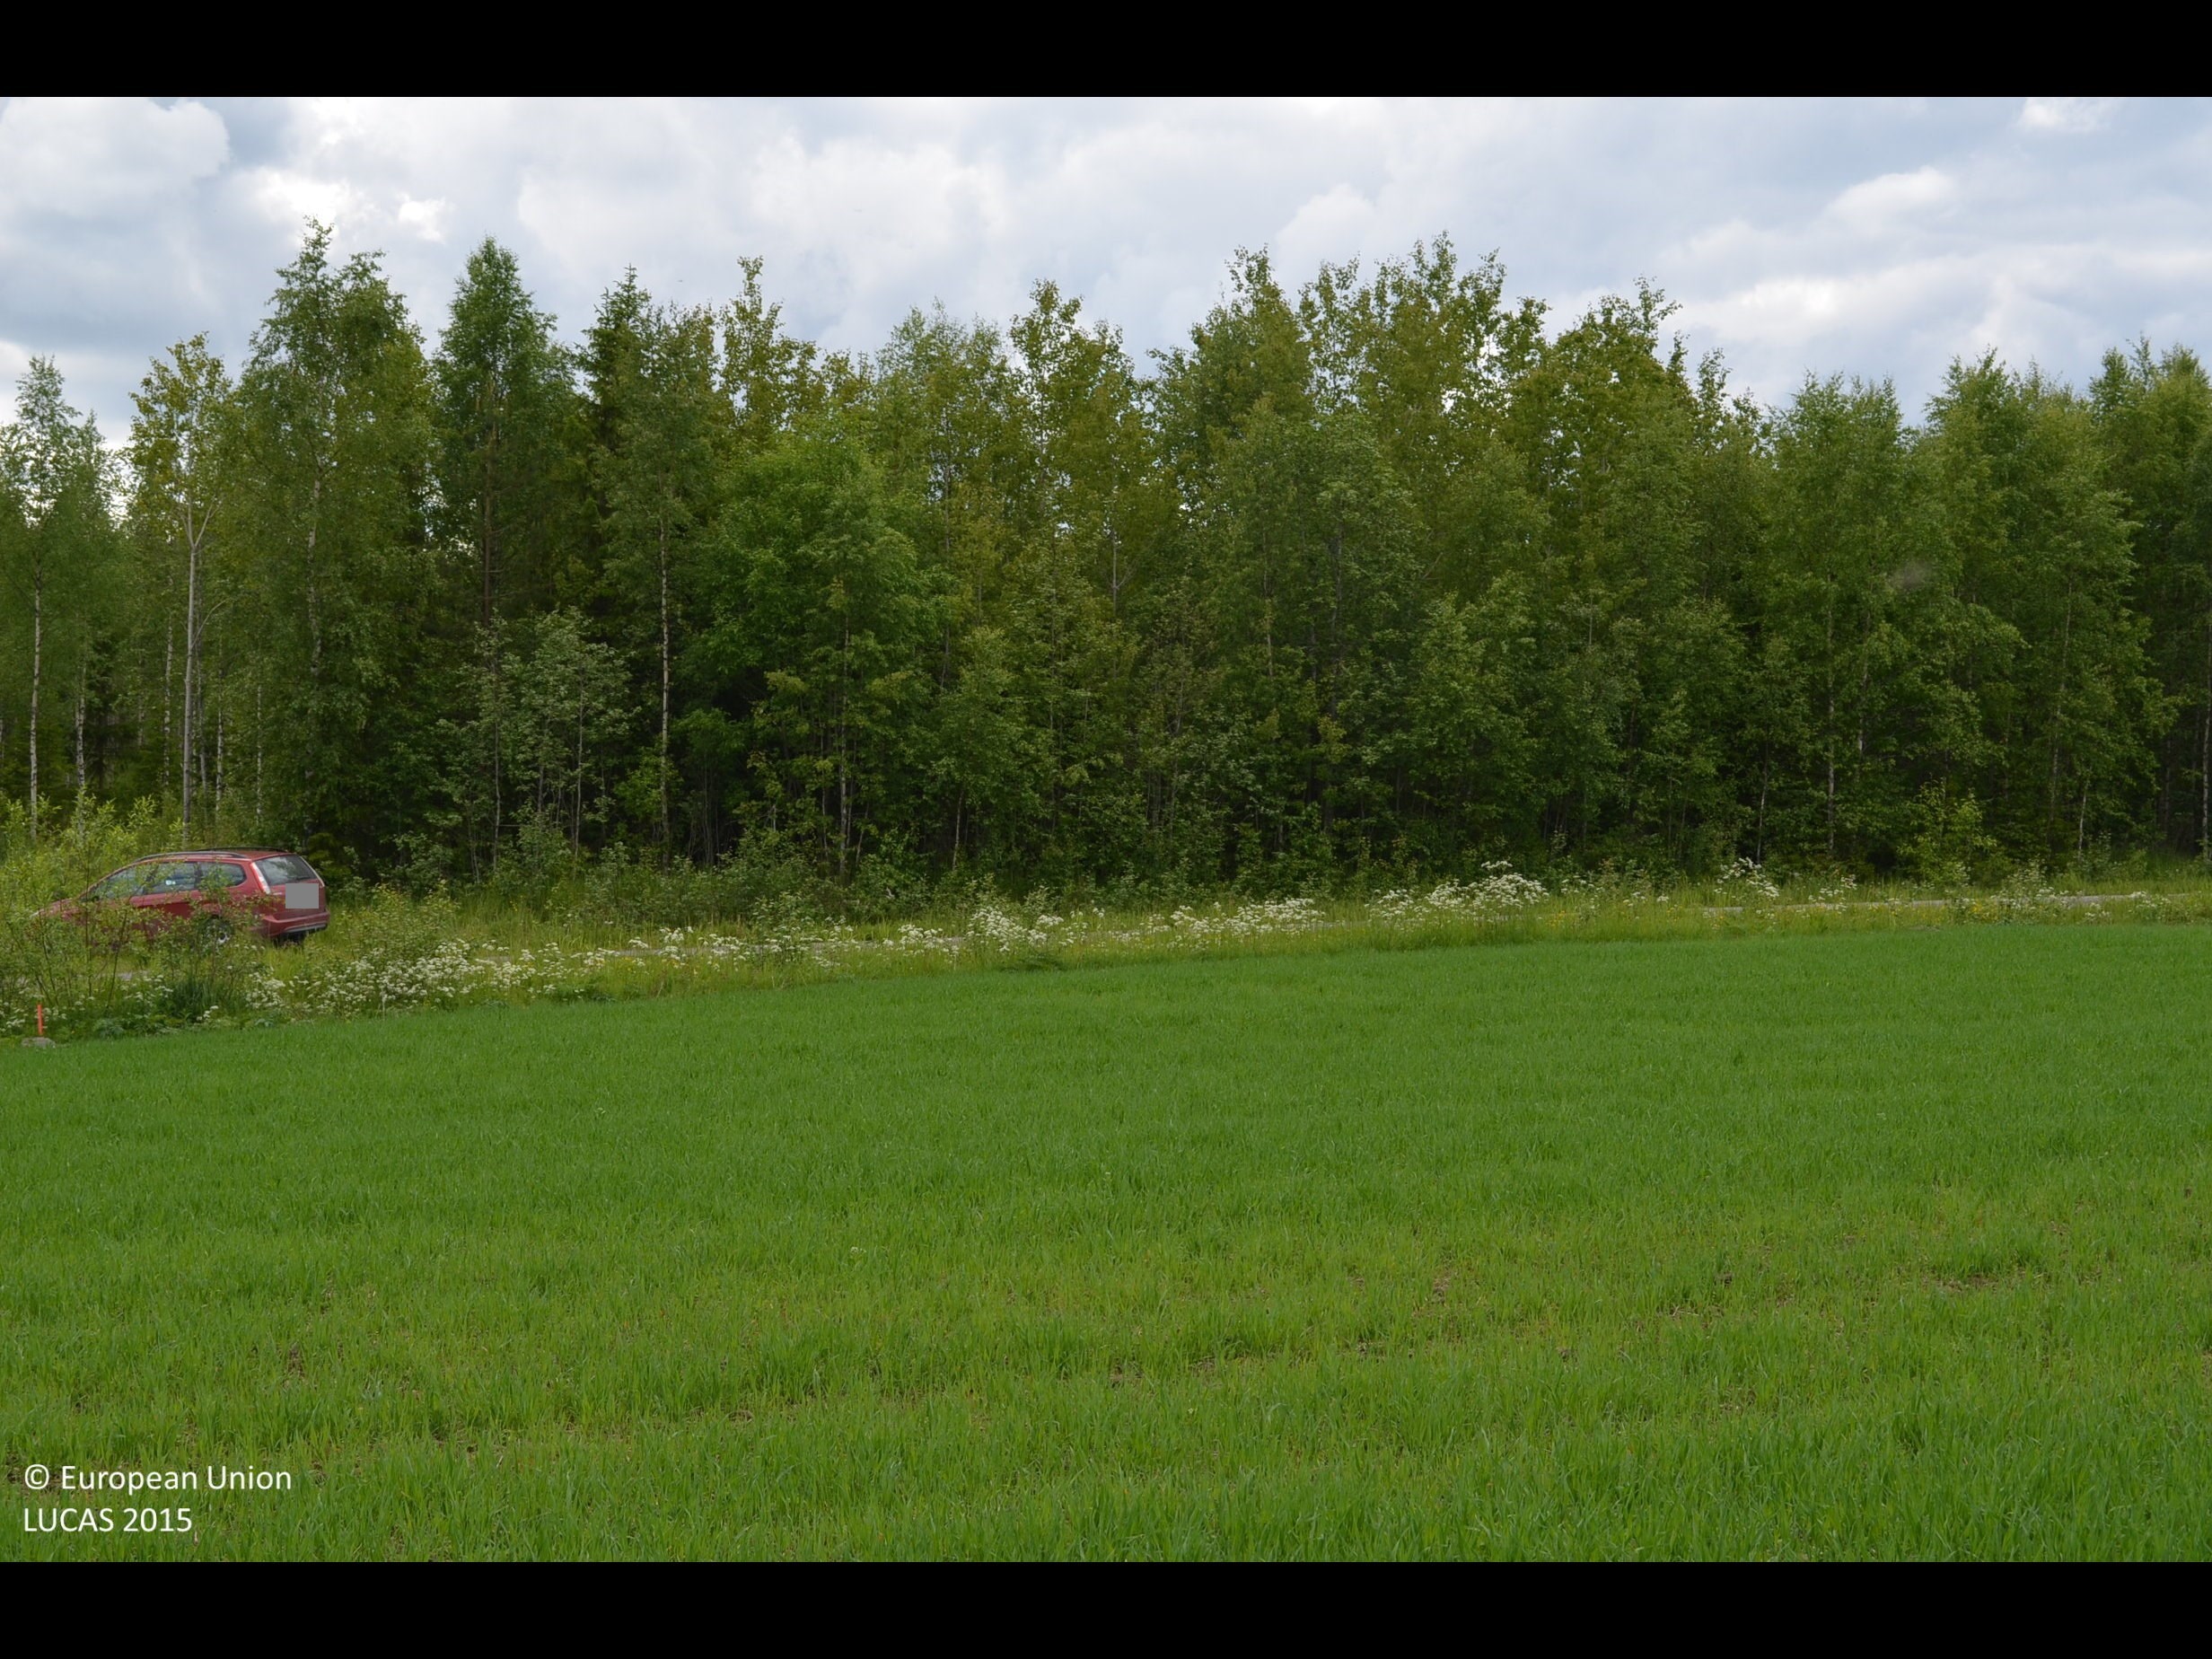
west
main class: Cropland
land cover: Oats
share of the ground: > 75 %
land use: Agriculture (excluding fallow land and kitchen gardens)
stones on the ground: 10 - 25 %
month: June
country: FI
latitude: 61.8314
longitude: 23.3474
